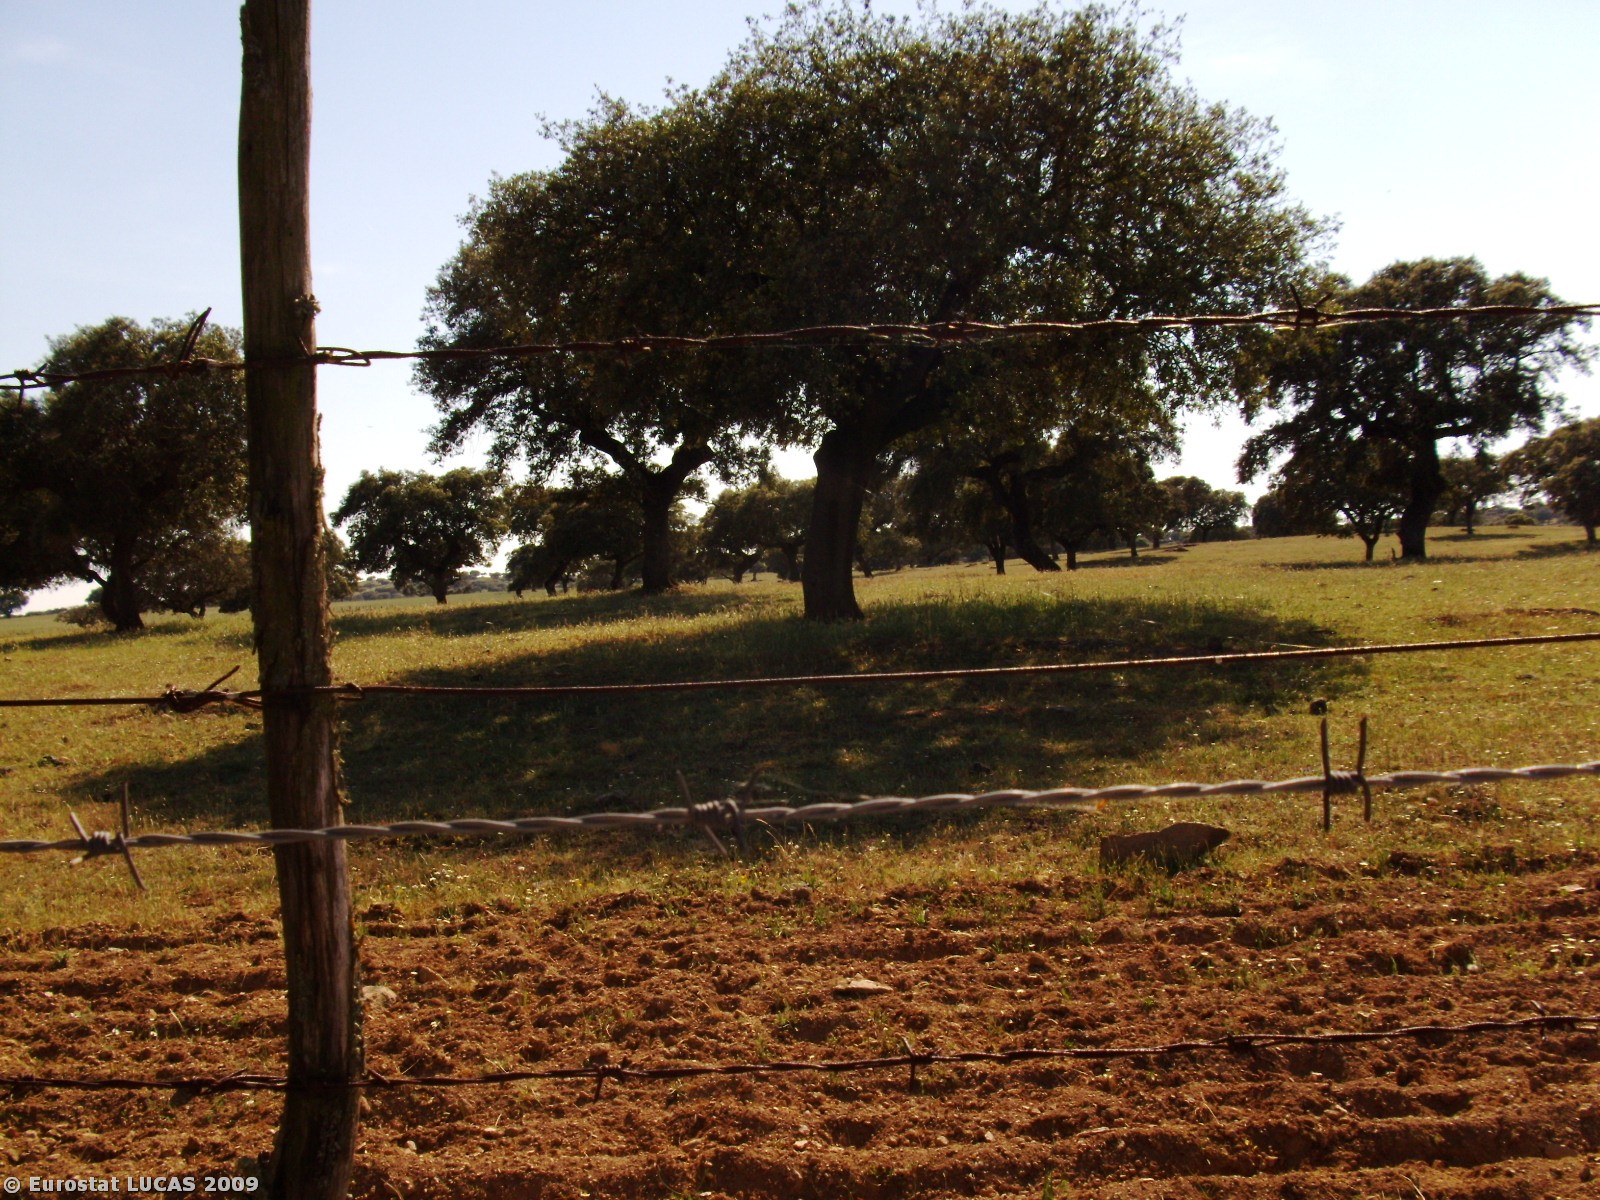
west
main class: Woodland
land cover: Broadleaved woodland
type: broadleaved evergreen forest
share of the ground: 25 - 50 %
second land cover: Spontaneously vegetated surfaces
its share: 50 - 75 %
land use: Agriculture (excluding fallow land and kitchen gardens)
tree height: > 5 m
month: May
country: PT
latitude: 38.8028
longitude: -7.3372
